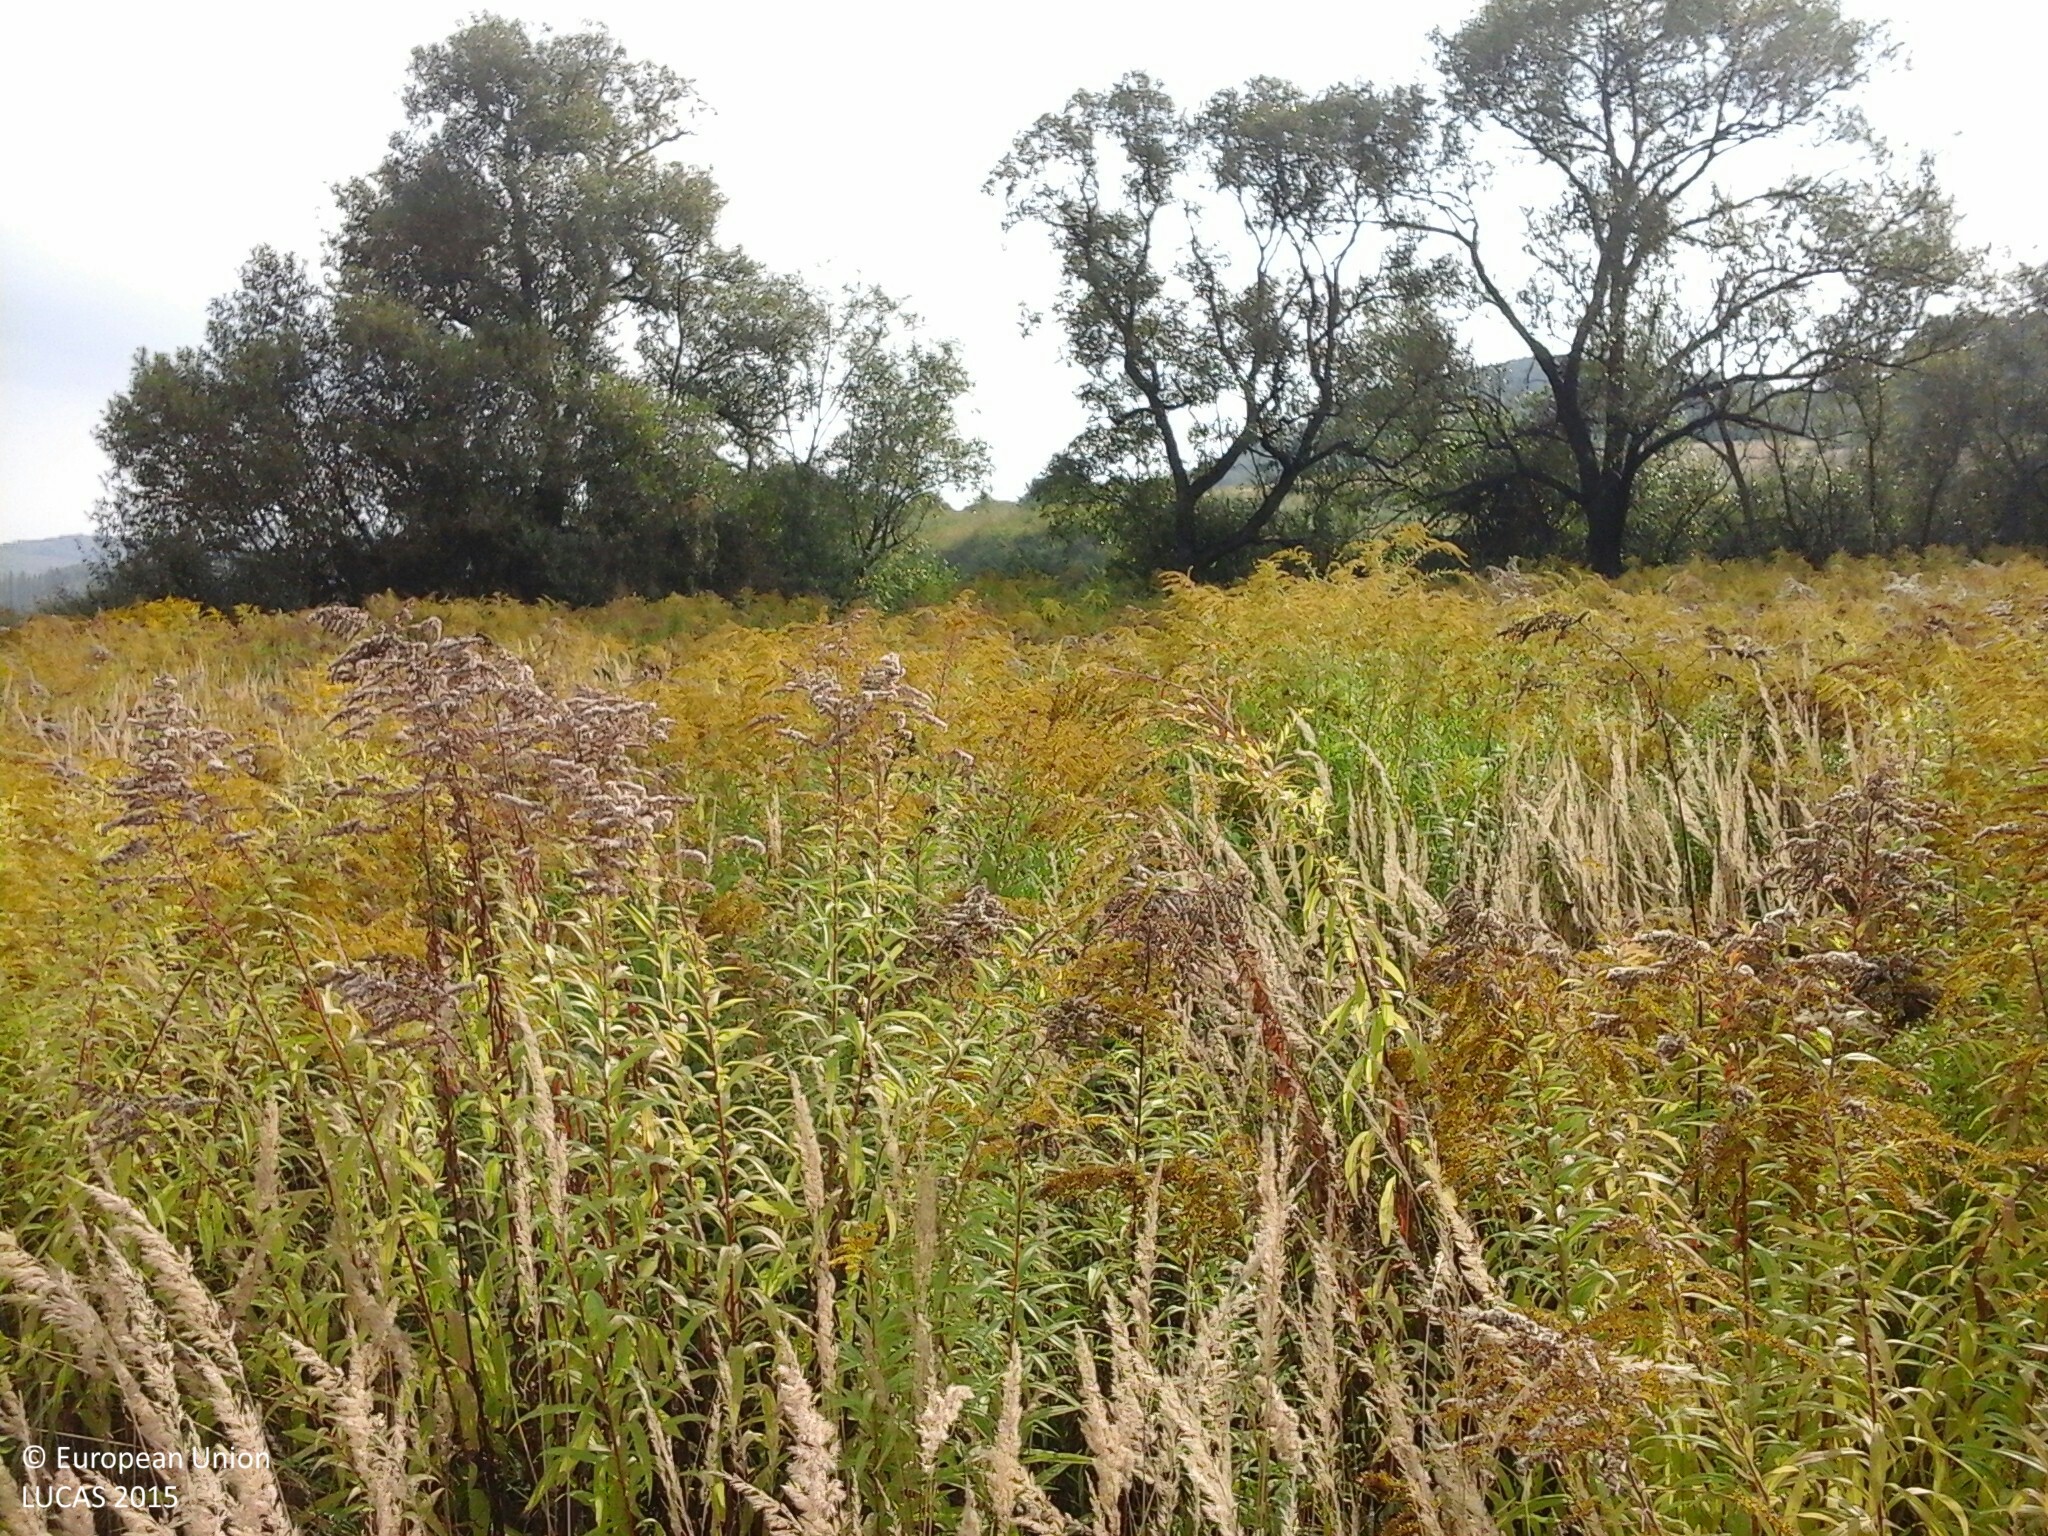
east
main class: Grassland
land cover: Spontaneously vegetated surfaces
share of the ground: > 75 %
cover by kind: herbaceous plants 100 %
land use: Abandoned areas
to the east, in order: Spontaneously vegetated surfaces; Shrubland with sparse tree cover; Grassland without tree/shrub cover; Tracks; Shrubland with sparse tree cover
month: September
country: HU
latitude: 47.9680
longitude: 19.7903
